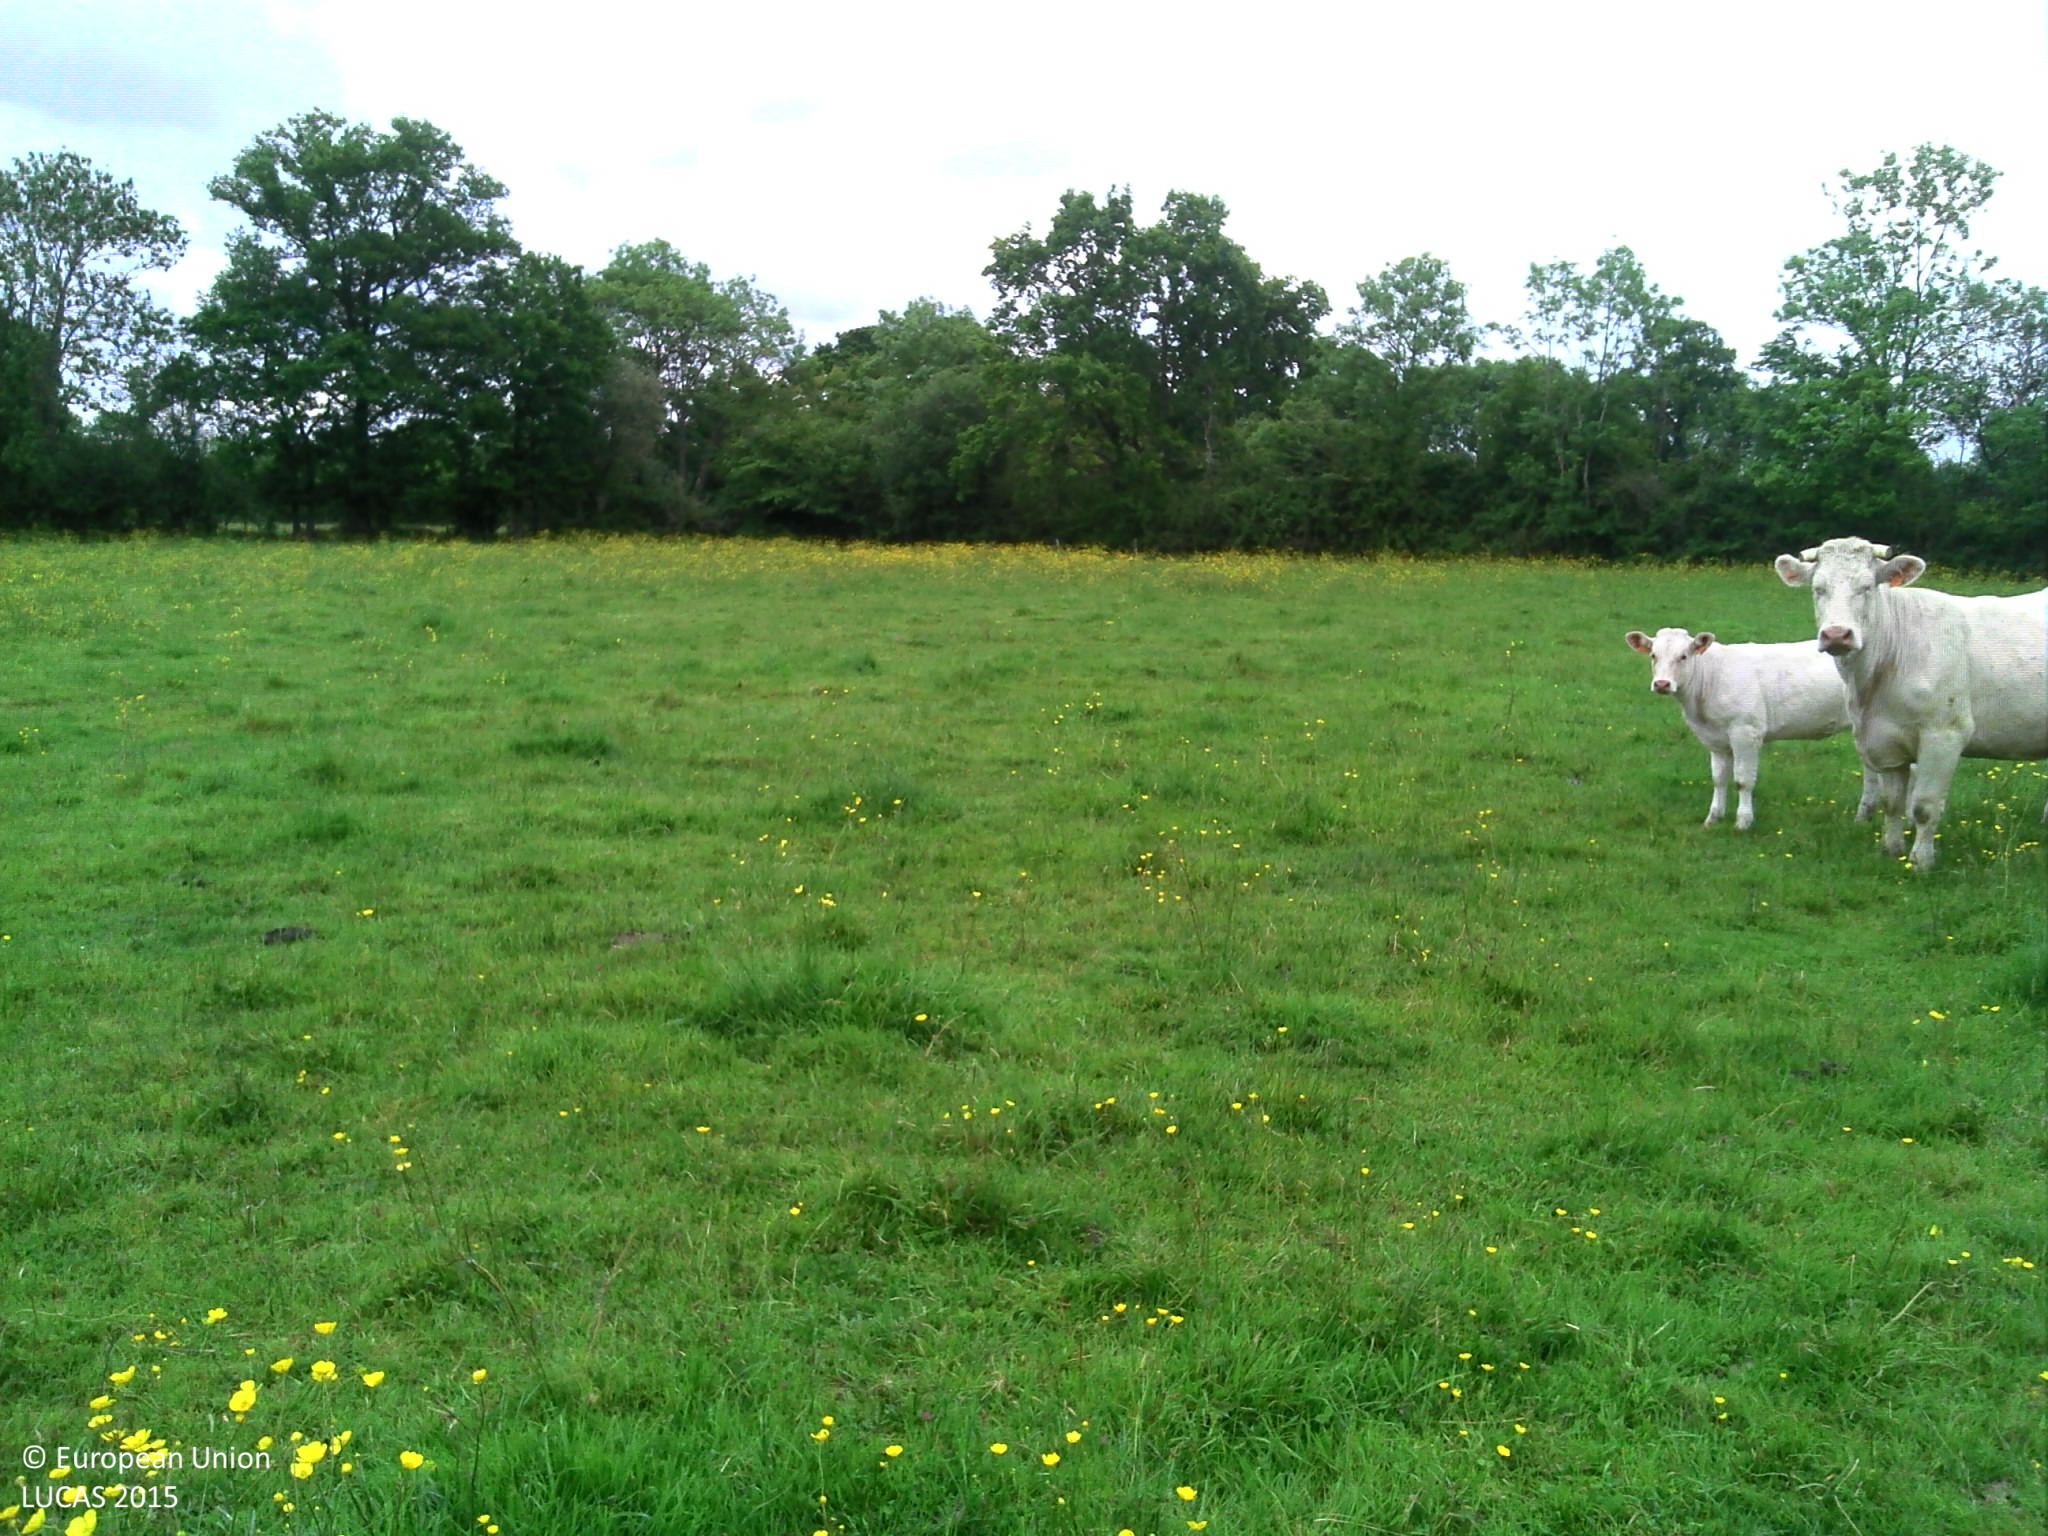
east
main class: Grassland
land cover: Grassland without tree/shrub cover
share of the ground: > 75 %
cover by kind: herbaceous plants 100 %
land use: Agriculture (excluding fallow land and kitchen gardens)
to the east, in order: Grassland without tree/shrub cover; Fences; Lines of trees; Grassland without tree/shrub cover; Fences; Lines of trees; Grass margins; Fences; Grassland without tree/shrub cover
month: May
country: FR
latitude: 49.3156
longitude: 0.0788
